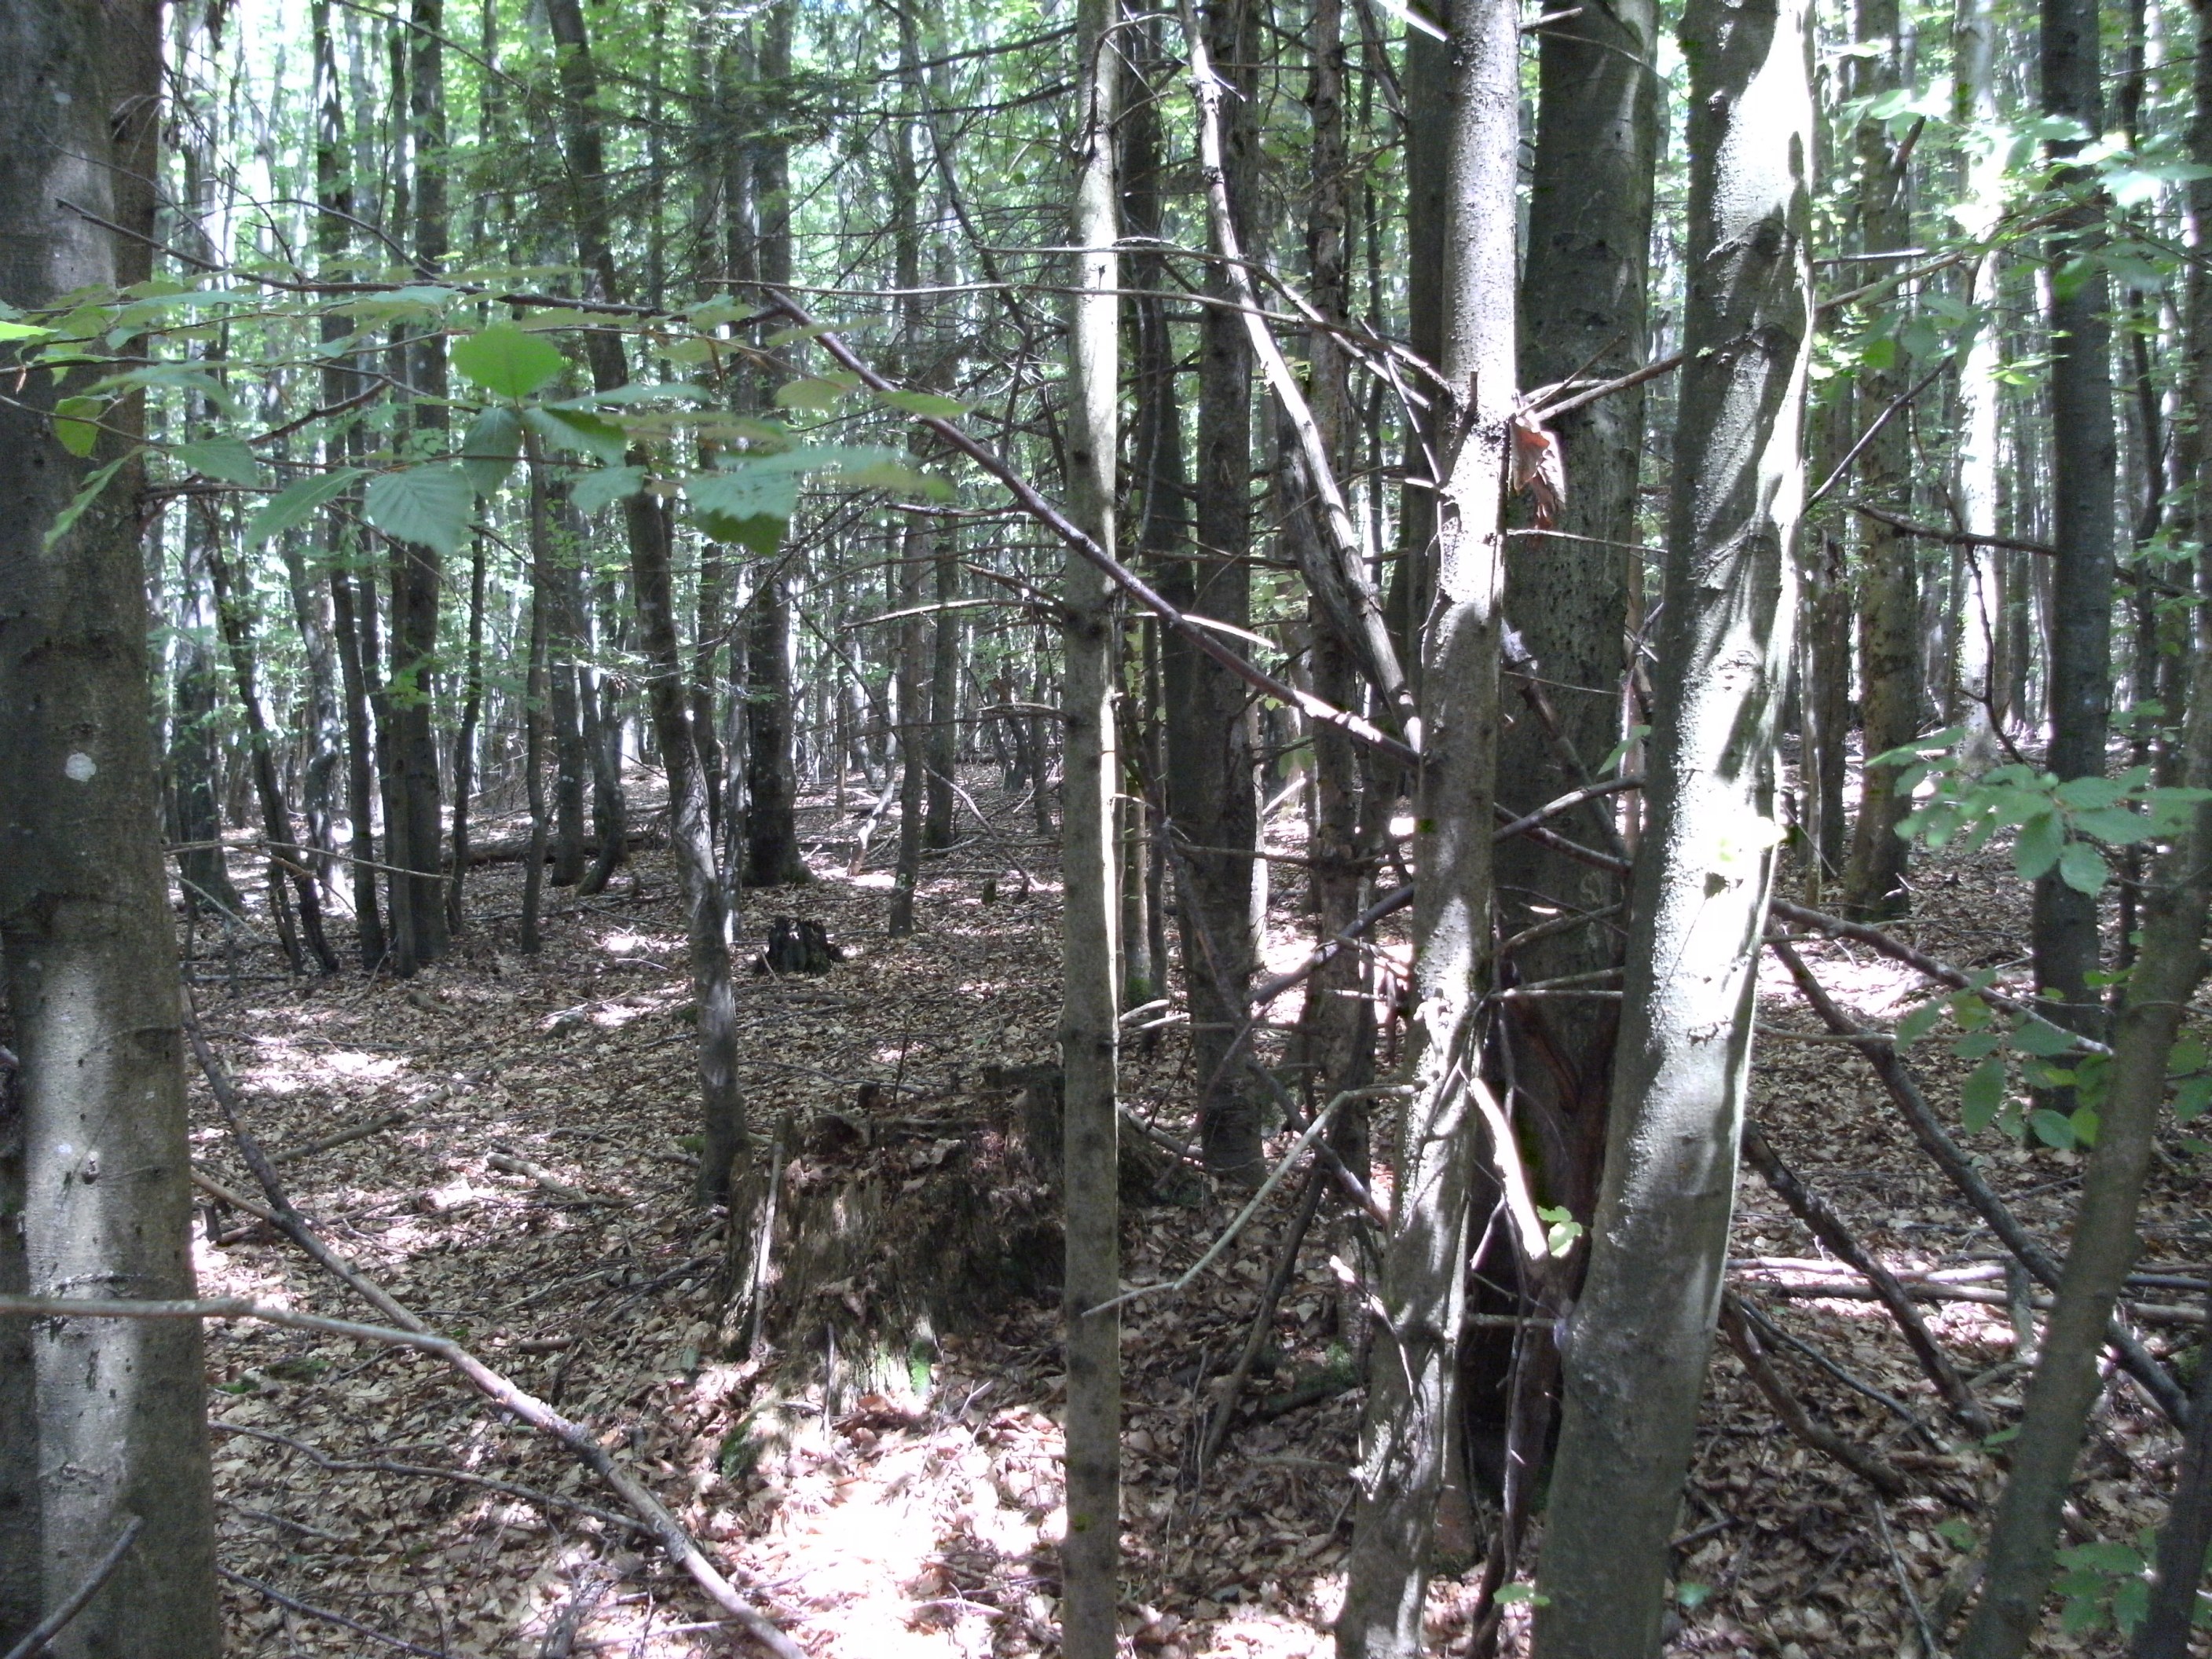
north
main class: Woodland
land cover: Broadleaved woodland
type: beech forest
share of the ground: > 75 %
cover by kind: broadleaved forest trees 85 %, coniferous forest trees 10 %, unconsolidated bare surface 5 %
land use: Forestry
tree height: > 5 m
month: June
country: AT
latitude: 48.0461
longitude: 13.3660
